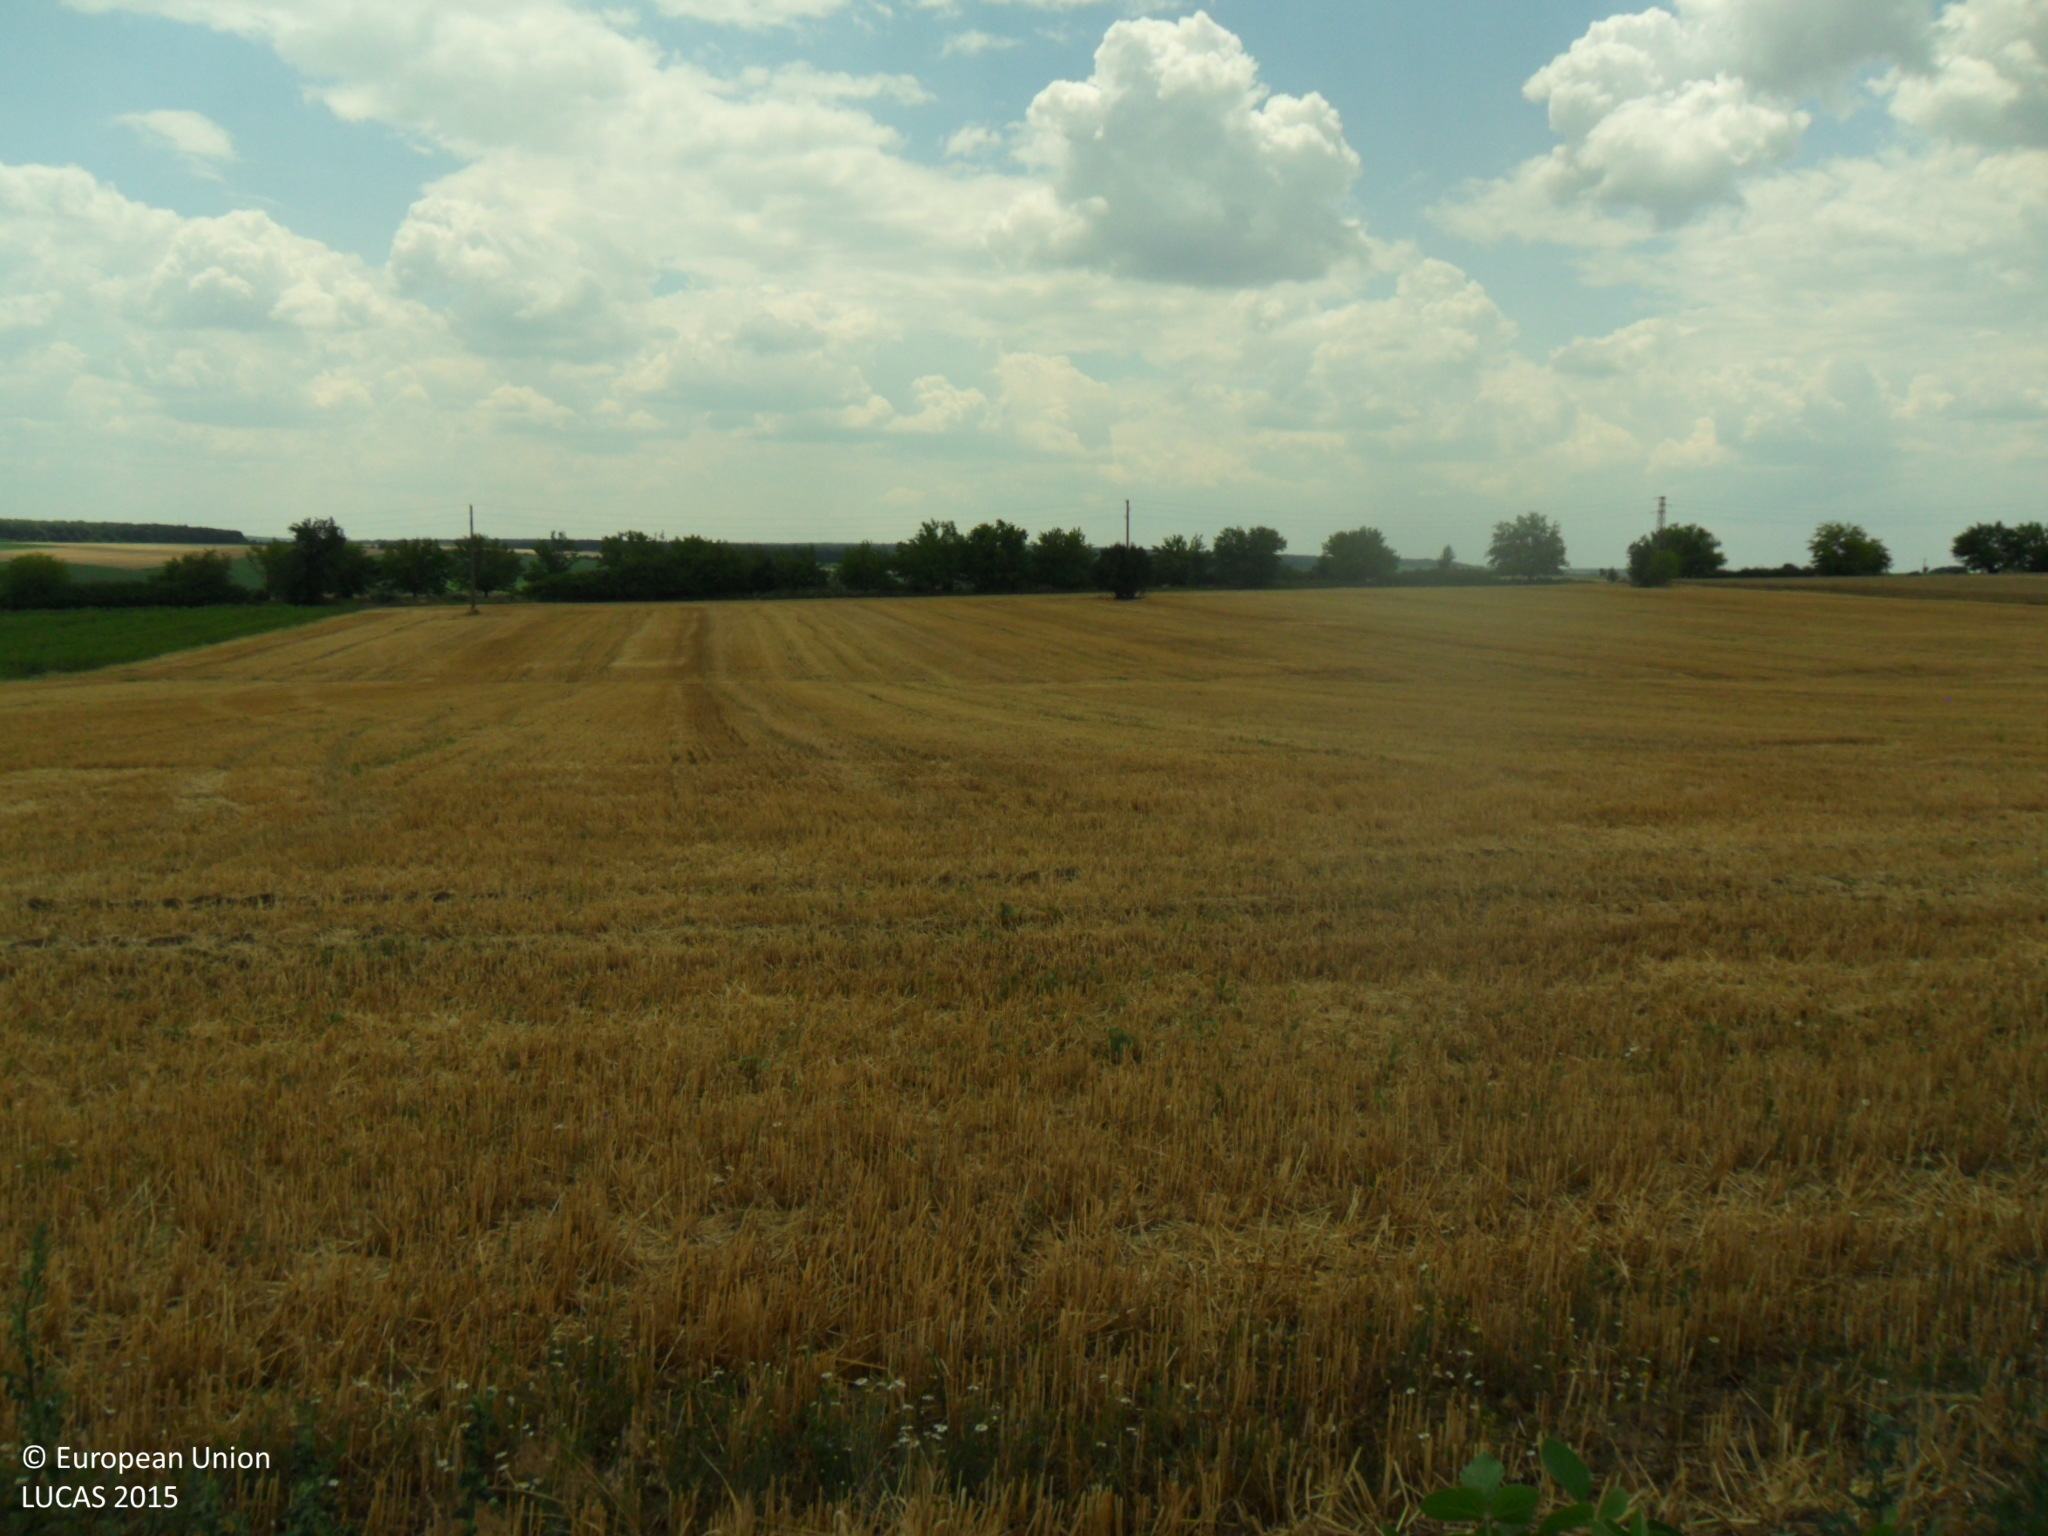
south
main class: Cropland
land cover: Soya
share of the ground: 50 - 75 %
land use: Agriculture (excluding fallow land and kitchen gardens)
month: July
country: BG
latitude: 43.6351
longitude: 26.8867
